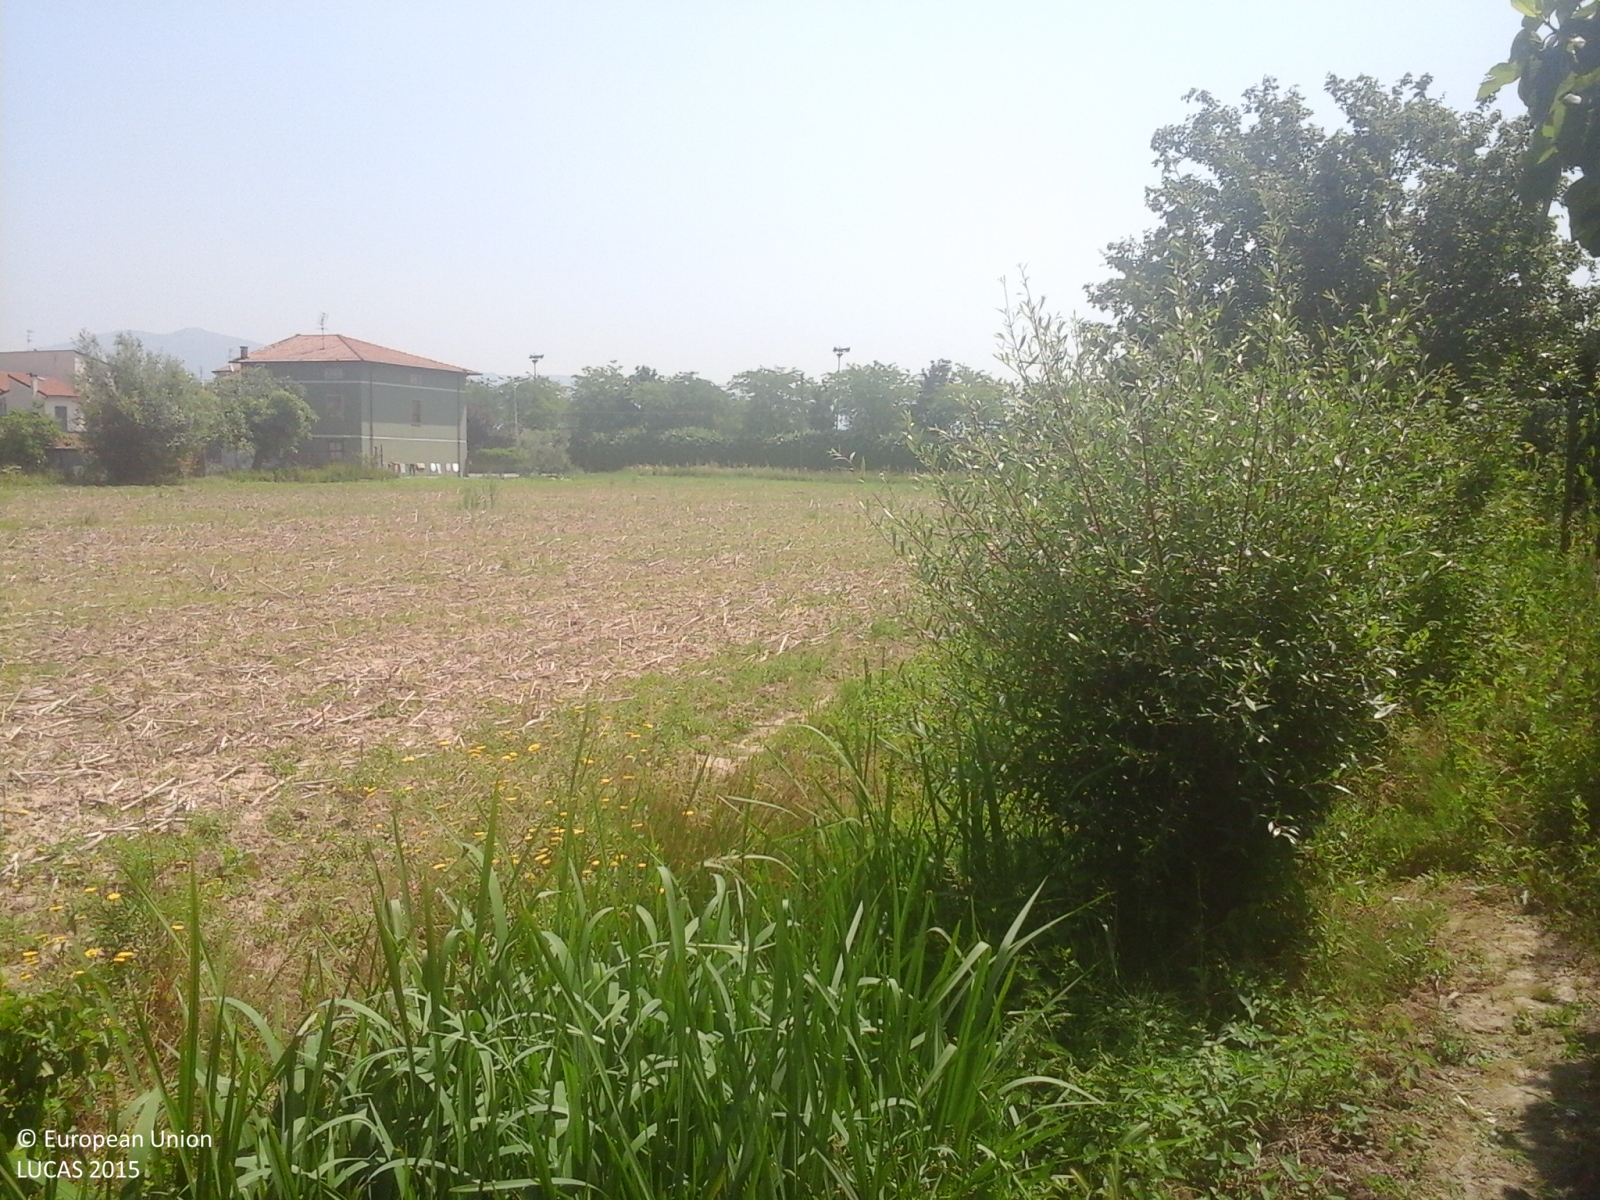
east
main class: Cropland
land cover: Clovers
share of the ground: > 75 %
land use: Agriculture (excluding fallow land and kitchen gardens)
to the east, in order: Clovers; Fences; Ditches and canals; Other bare soil; Ditches and canals; Grass margins; Paved roads, cycling and walking lanes; Electric lines; Managed hedges; Fences; Artificial constructions; Fences; Grassland without tree/shrub cover; Fences; Paved roads, cycling and walking lanes; Artificial constructions
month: June
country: IT
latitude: 43.8764
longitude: 11.0303
